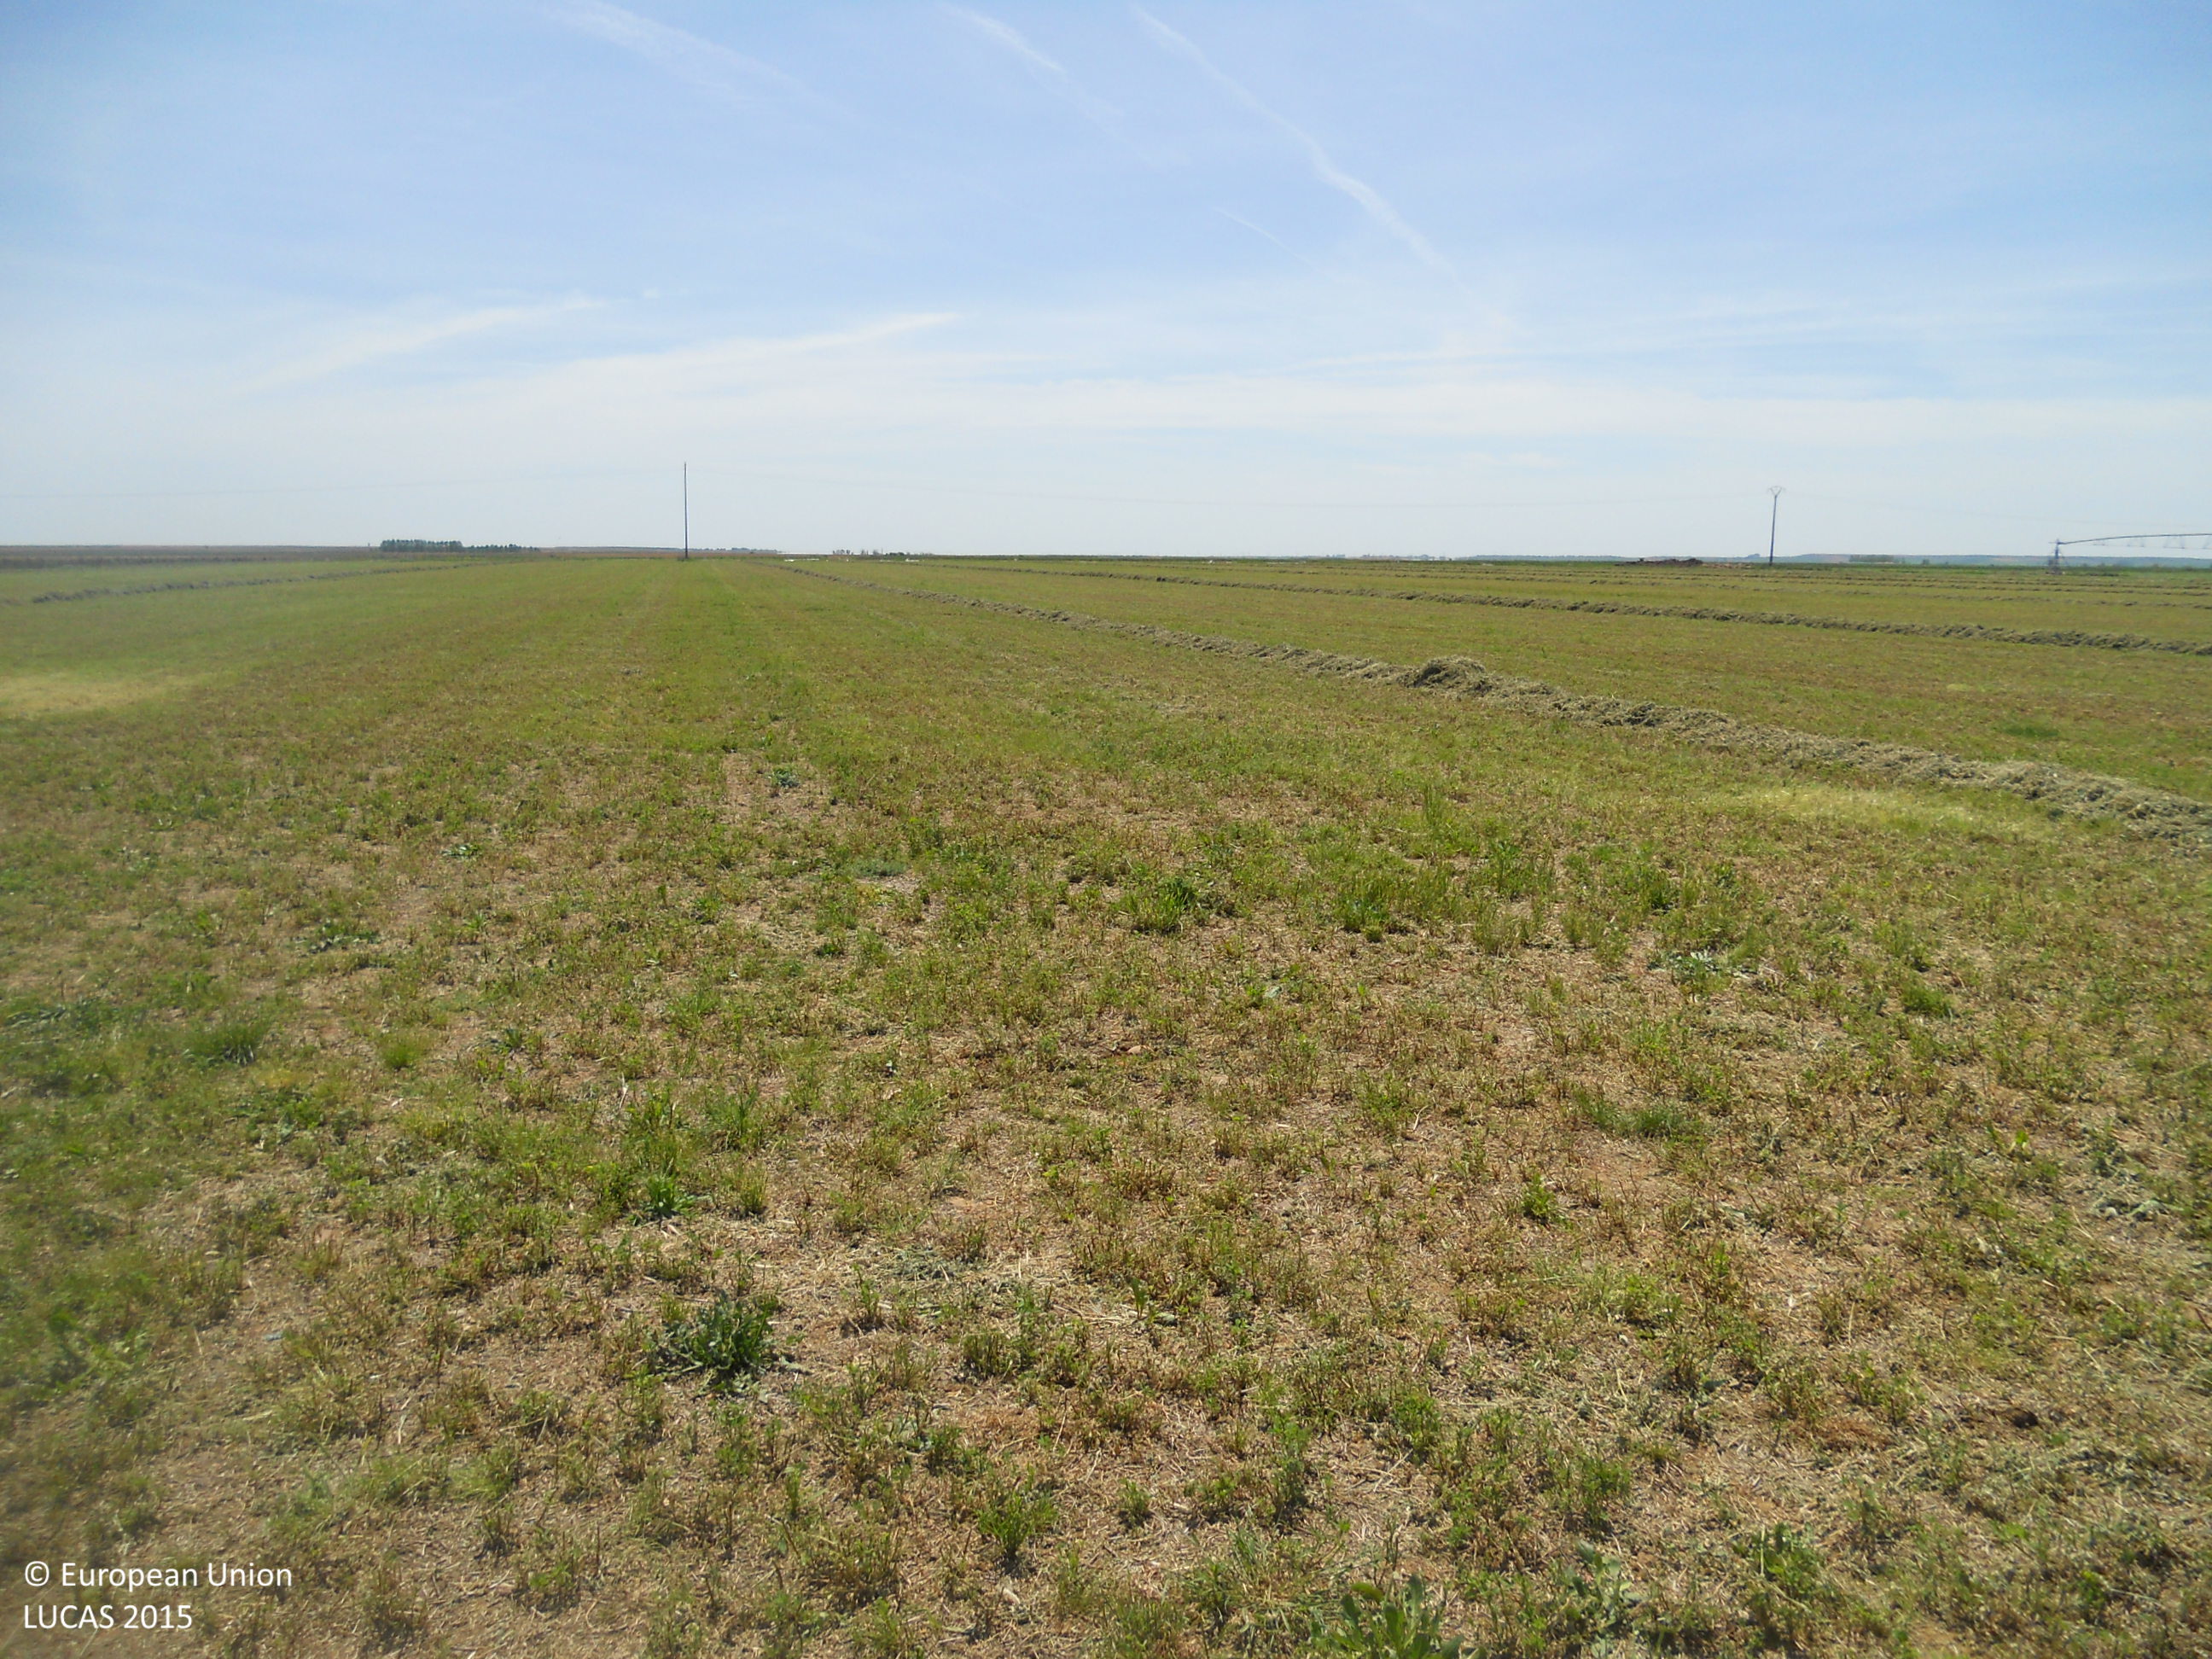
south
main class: Cropland
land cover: Lucerne
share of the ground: > 75 %
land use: Agriculture (excluding fallow land and kitchen gardens)
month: May
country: ES
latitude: 42.4028
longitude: -5.2883
